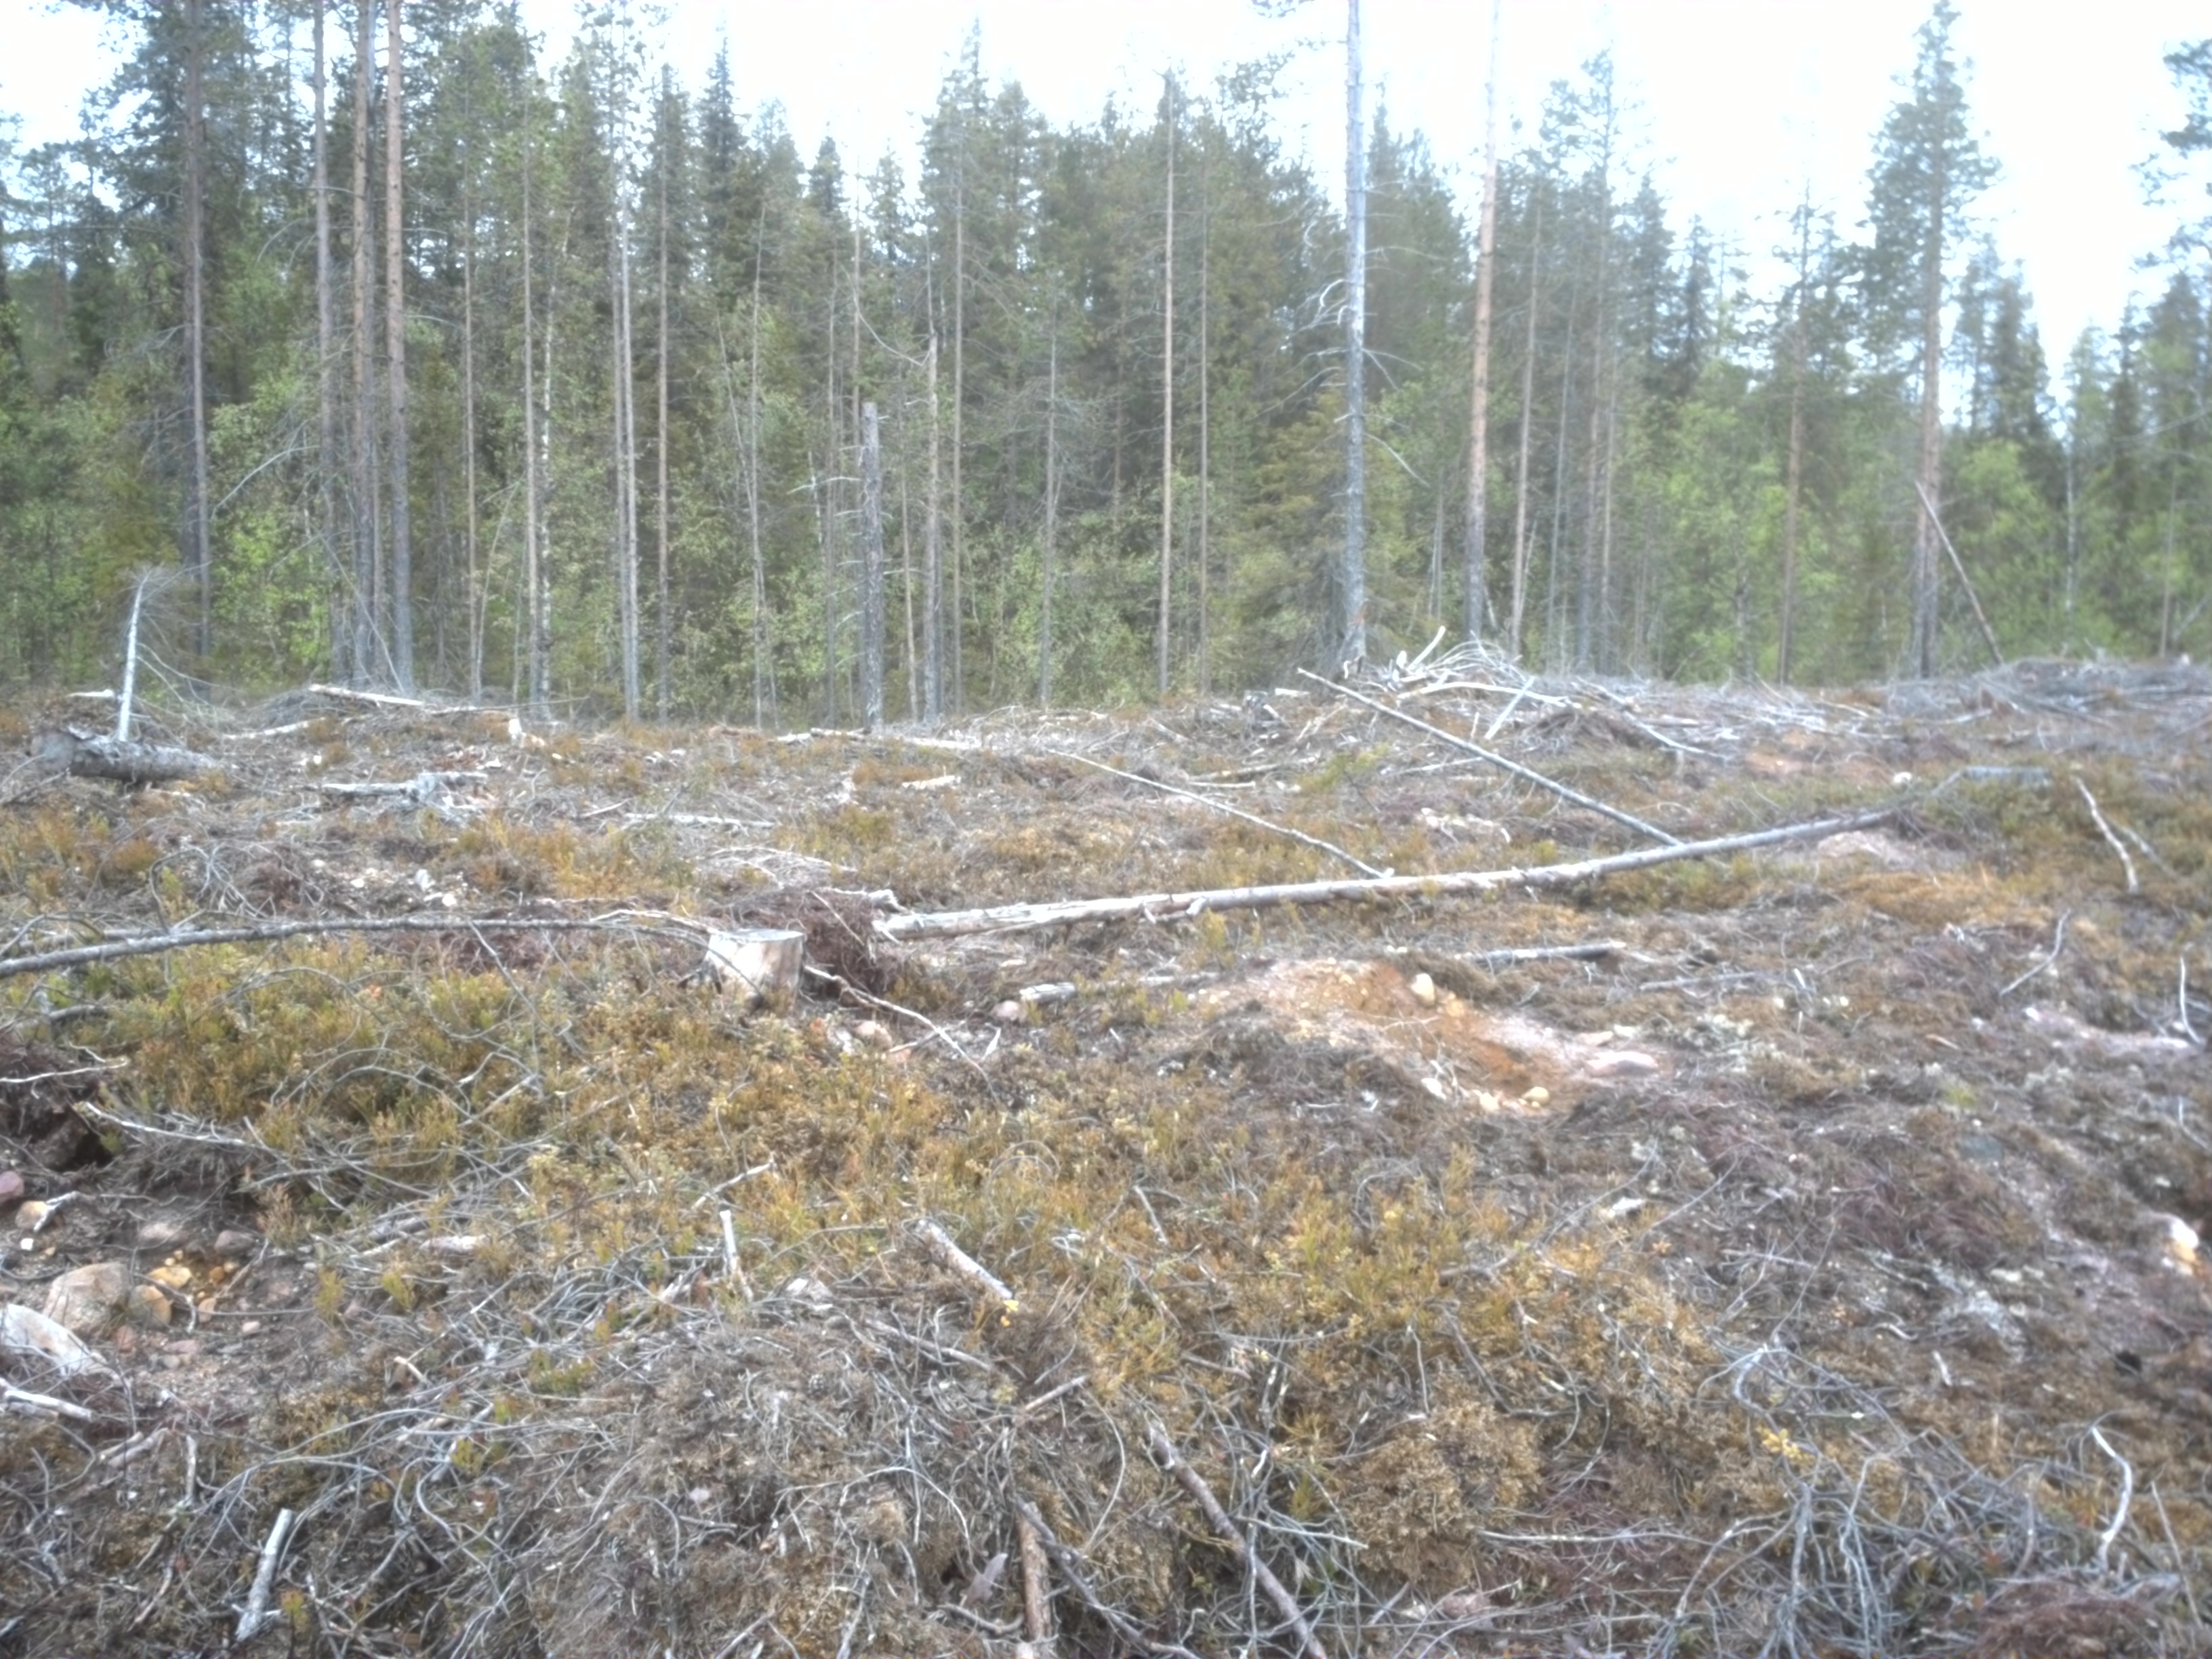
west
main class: Shrubland
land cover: Shrubland with sparse tree cover
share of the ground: 50 - 75 %
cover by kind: shrubs 60 %, unconsolidated bare surface 35 %, coniferous forest trees 5 %
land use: Forestry
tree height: > 5 m
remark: Clear cut
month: June
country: SE
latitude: 66.9980
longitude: 21.8148
